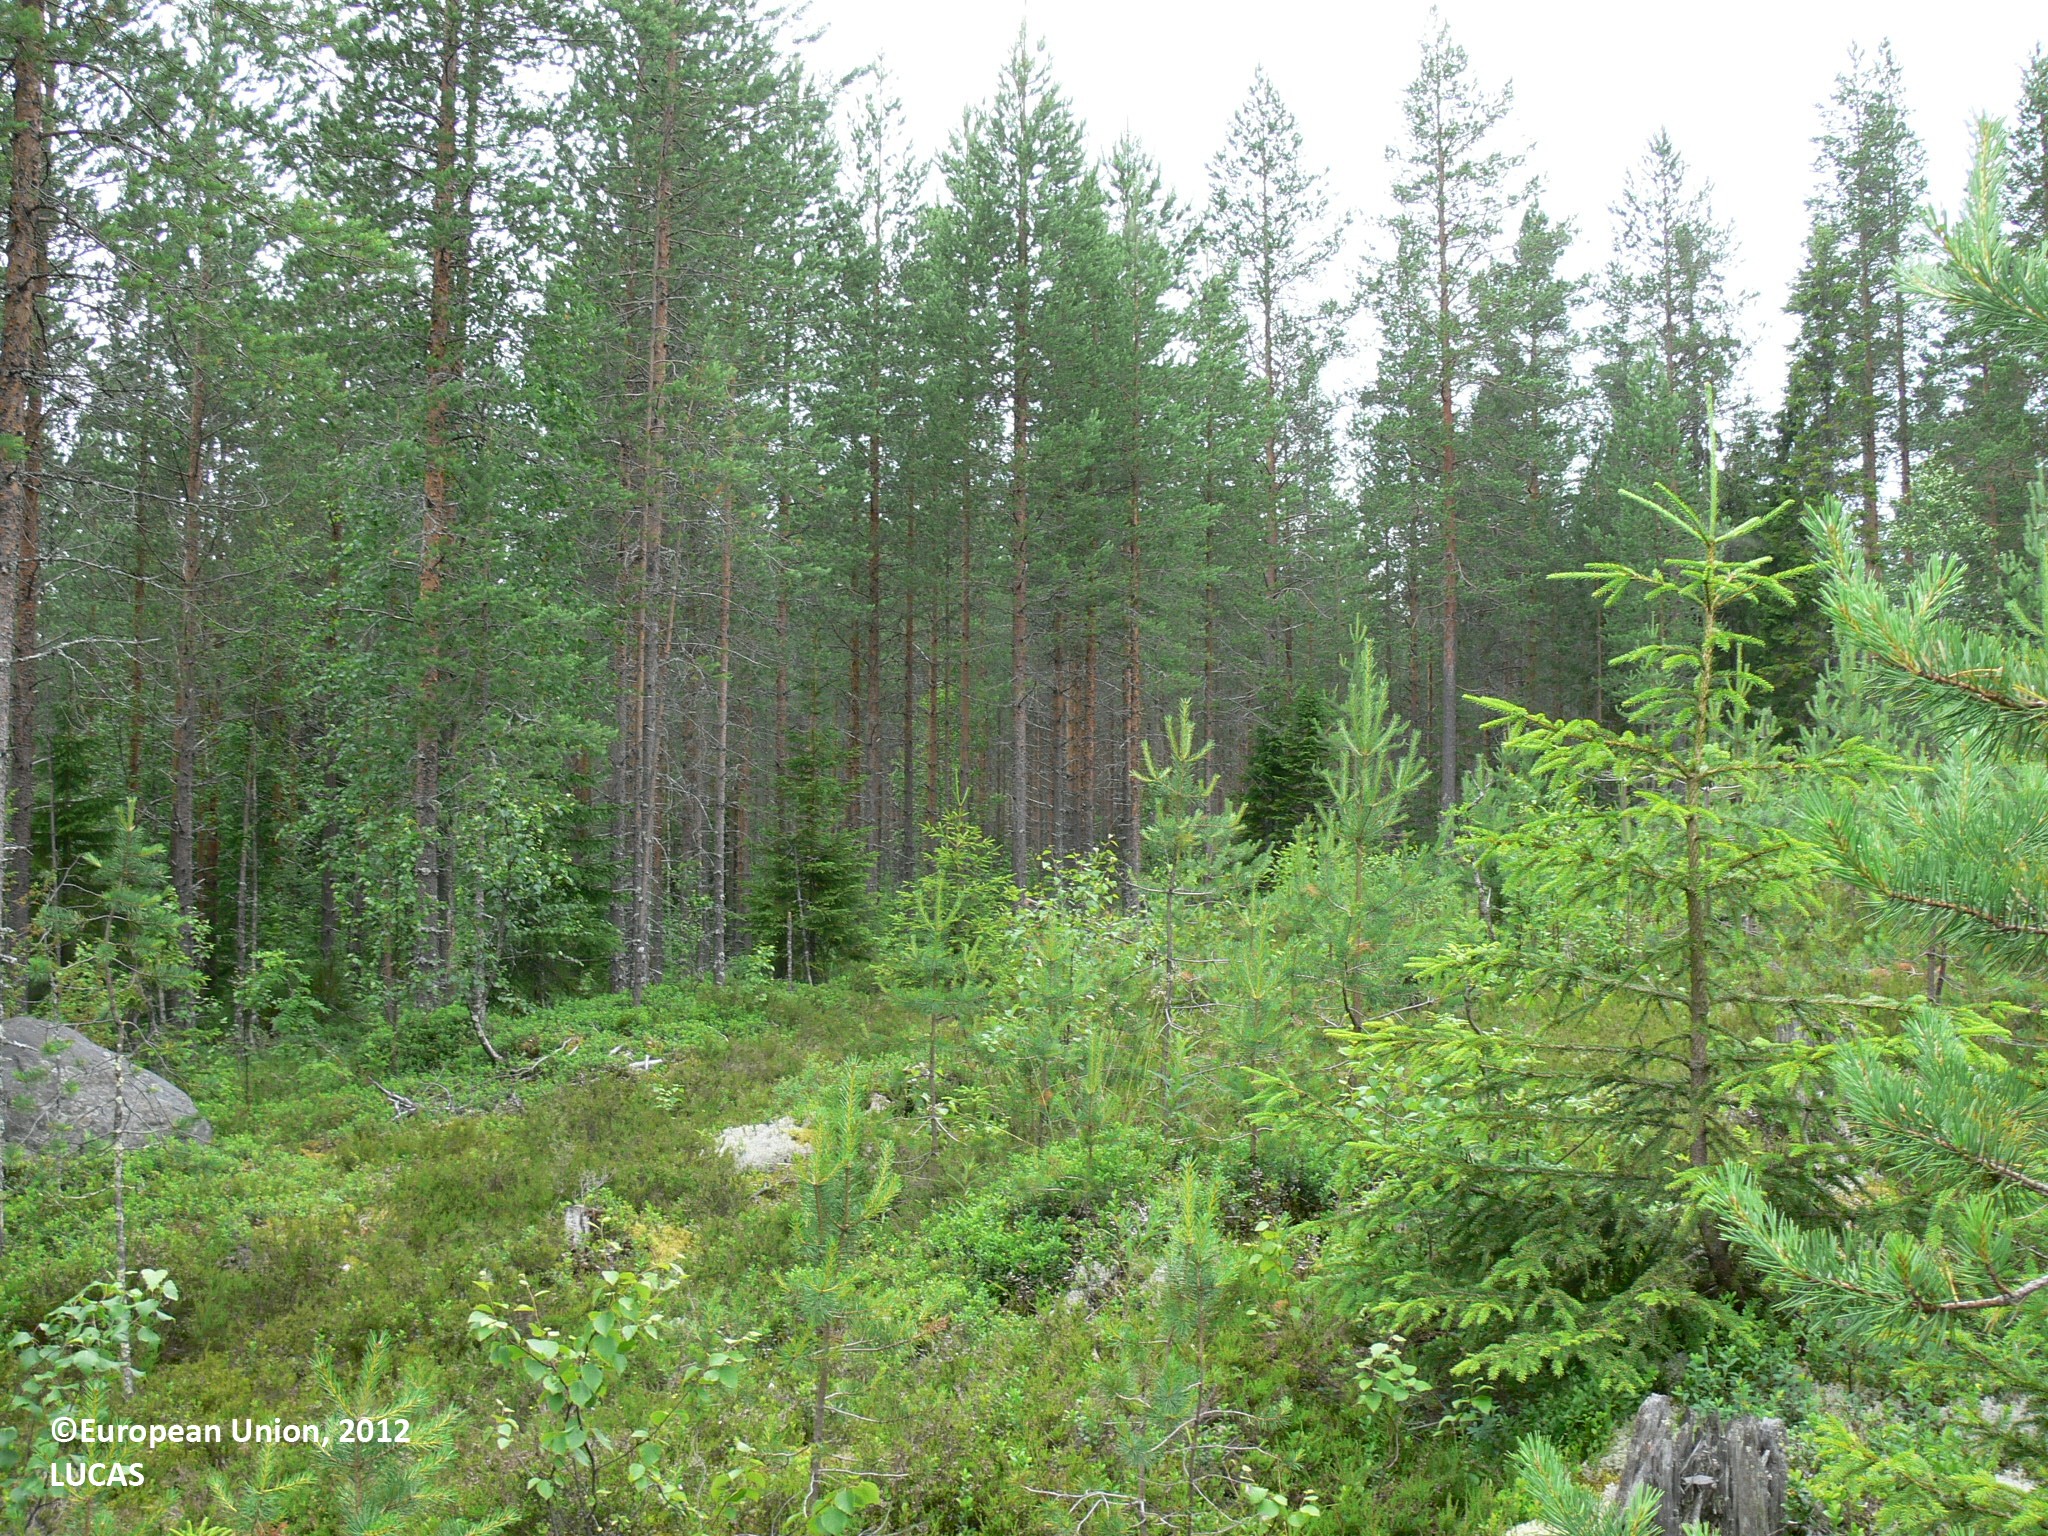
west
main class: Woodland
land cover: Pine dominated coniferous woodland
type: boreal forest
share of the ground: 25 - 50 %
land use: Forestry
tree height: < 5 m
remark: Clear cut
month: July
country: FI
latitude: 63.2578
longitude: 30.7830
